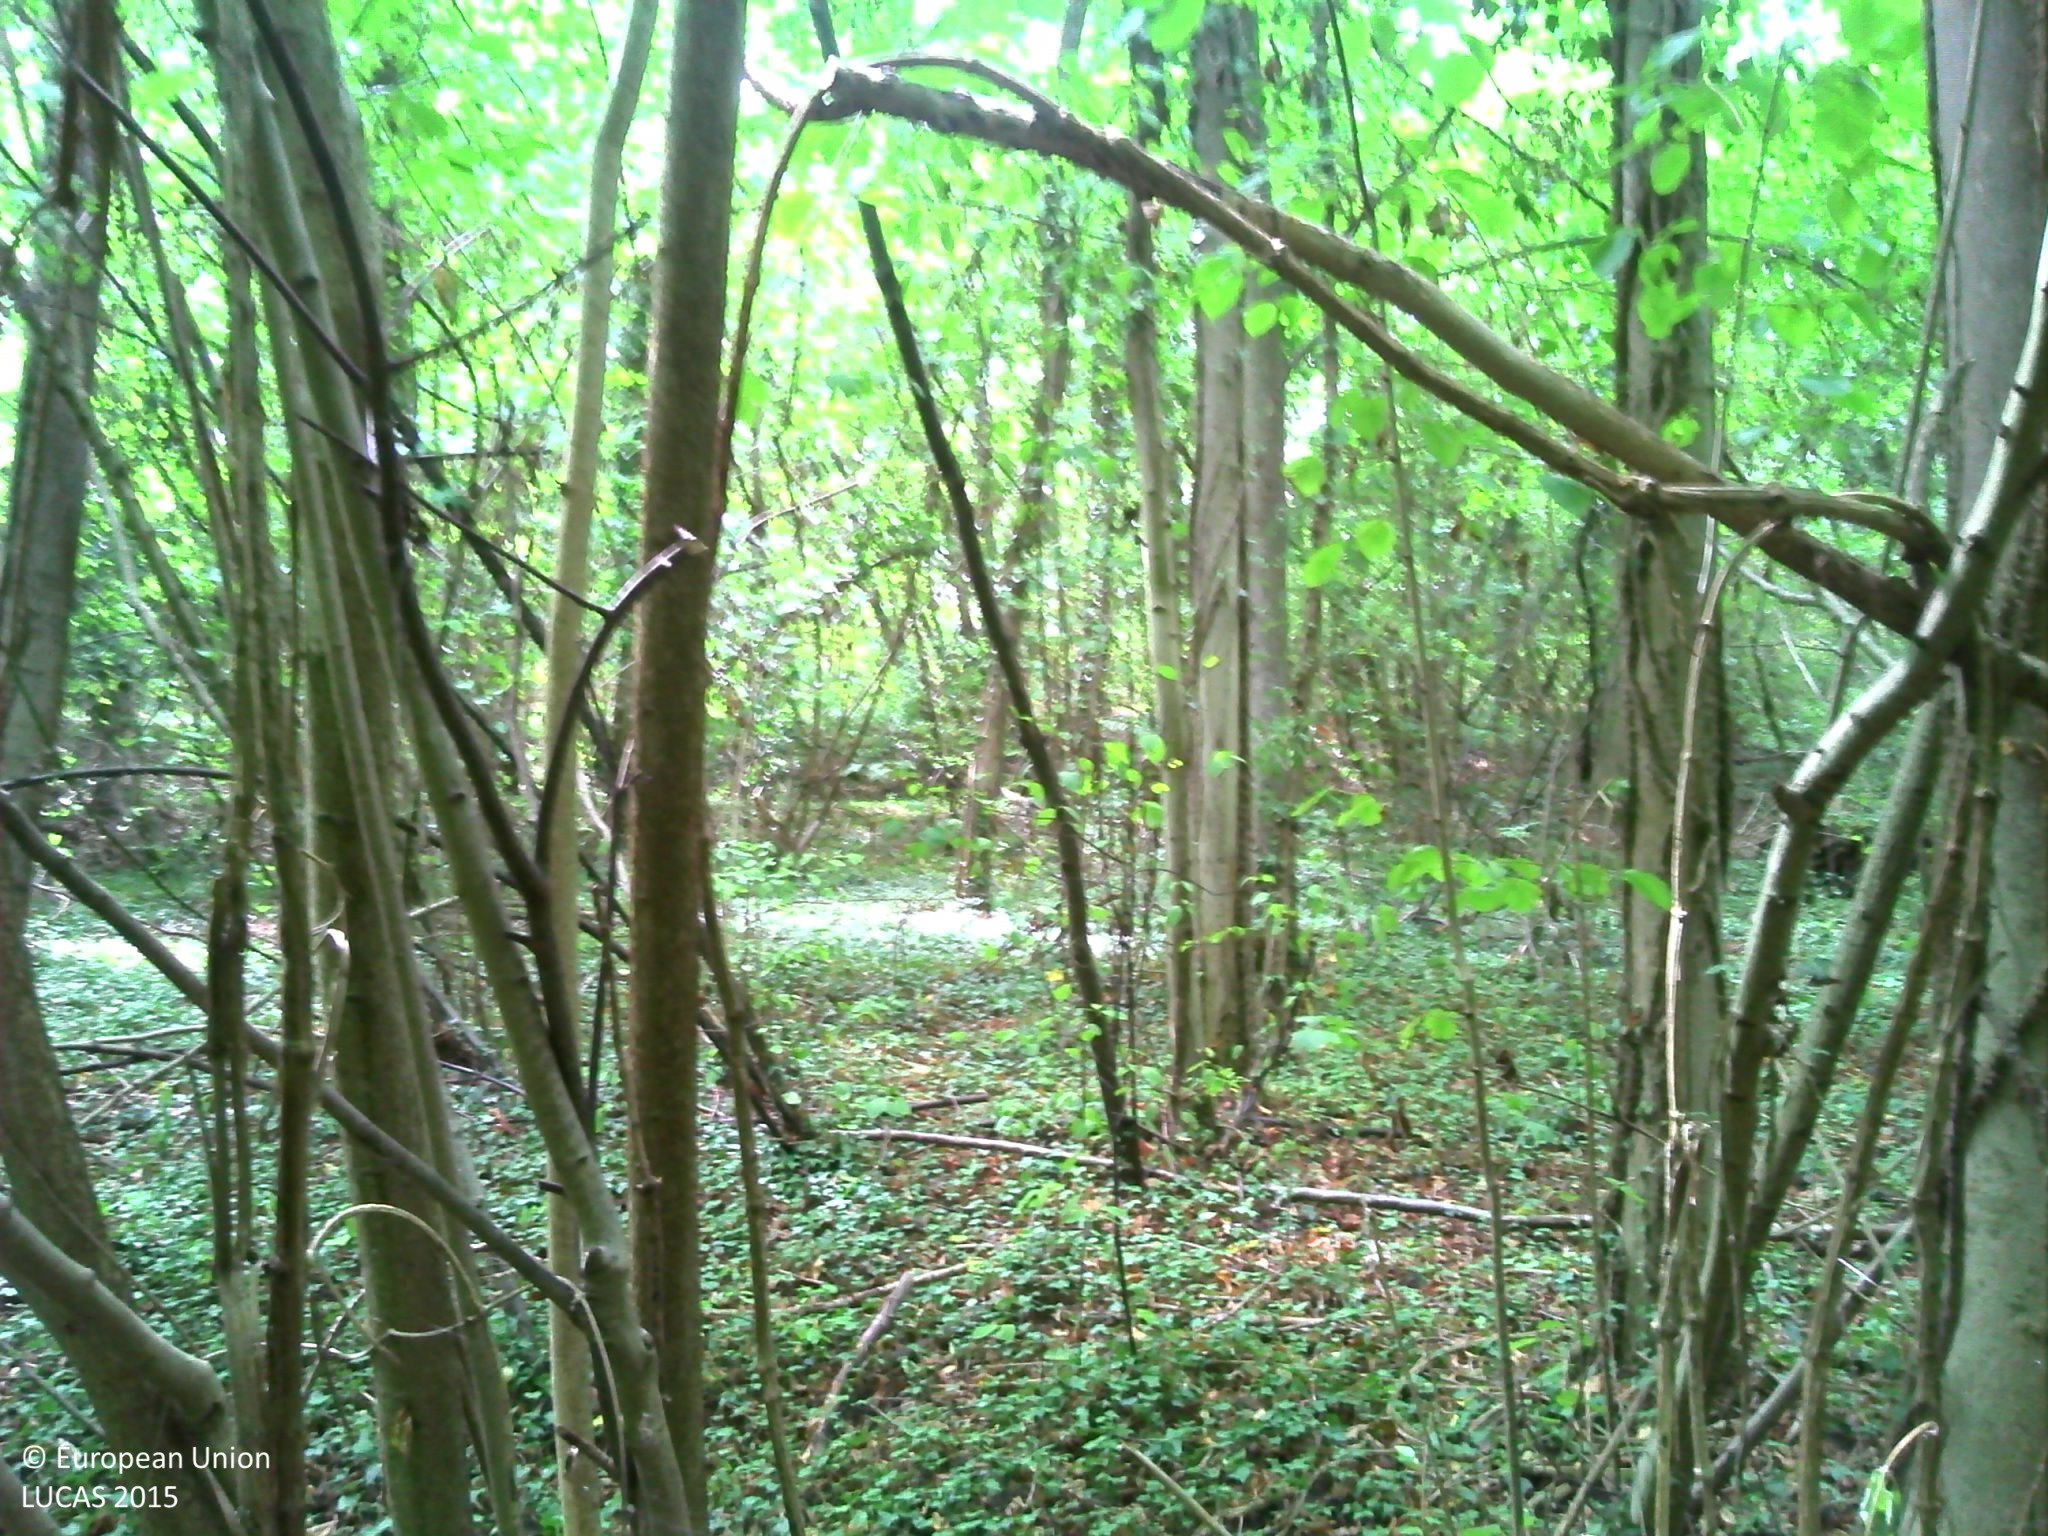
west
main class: Woodland
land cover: Broadleaved woodland
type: mesophytic deciduous forest
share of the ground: > 75 %
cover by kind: broadleaved forest trees 95 %, herbaceous plants 5 %
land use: Forestry
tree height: > 5 m
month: August
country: FR
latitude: 48.5064
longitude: 7.7404
